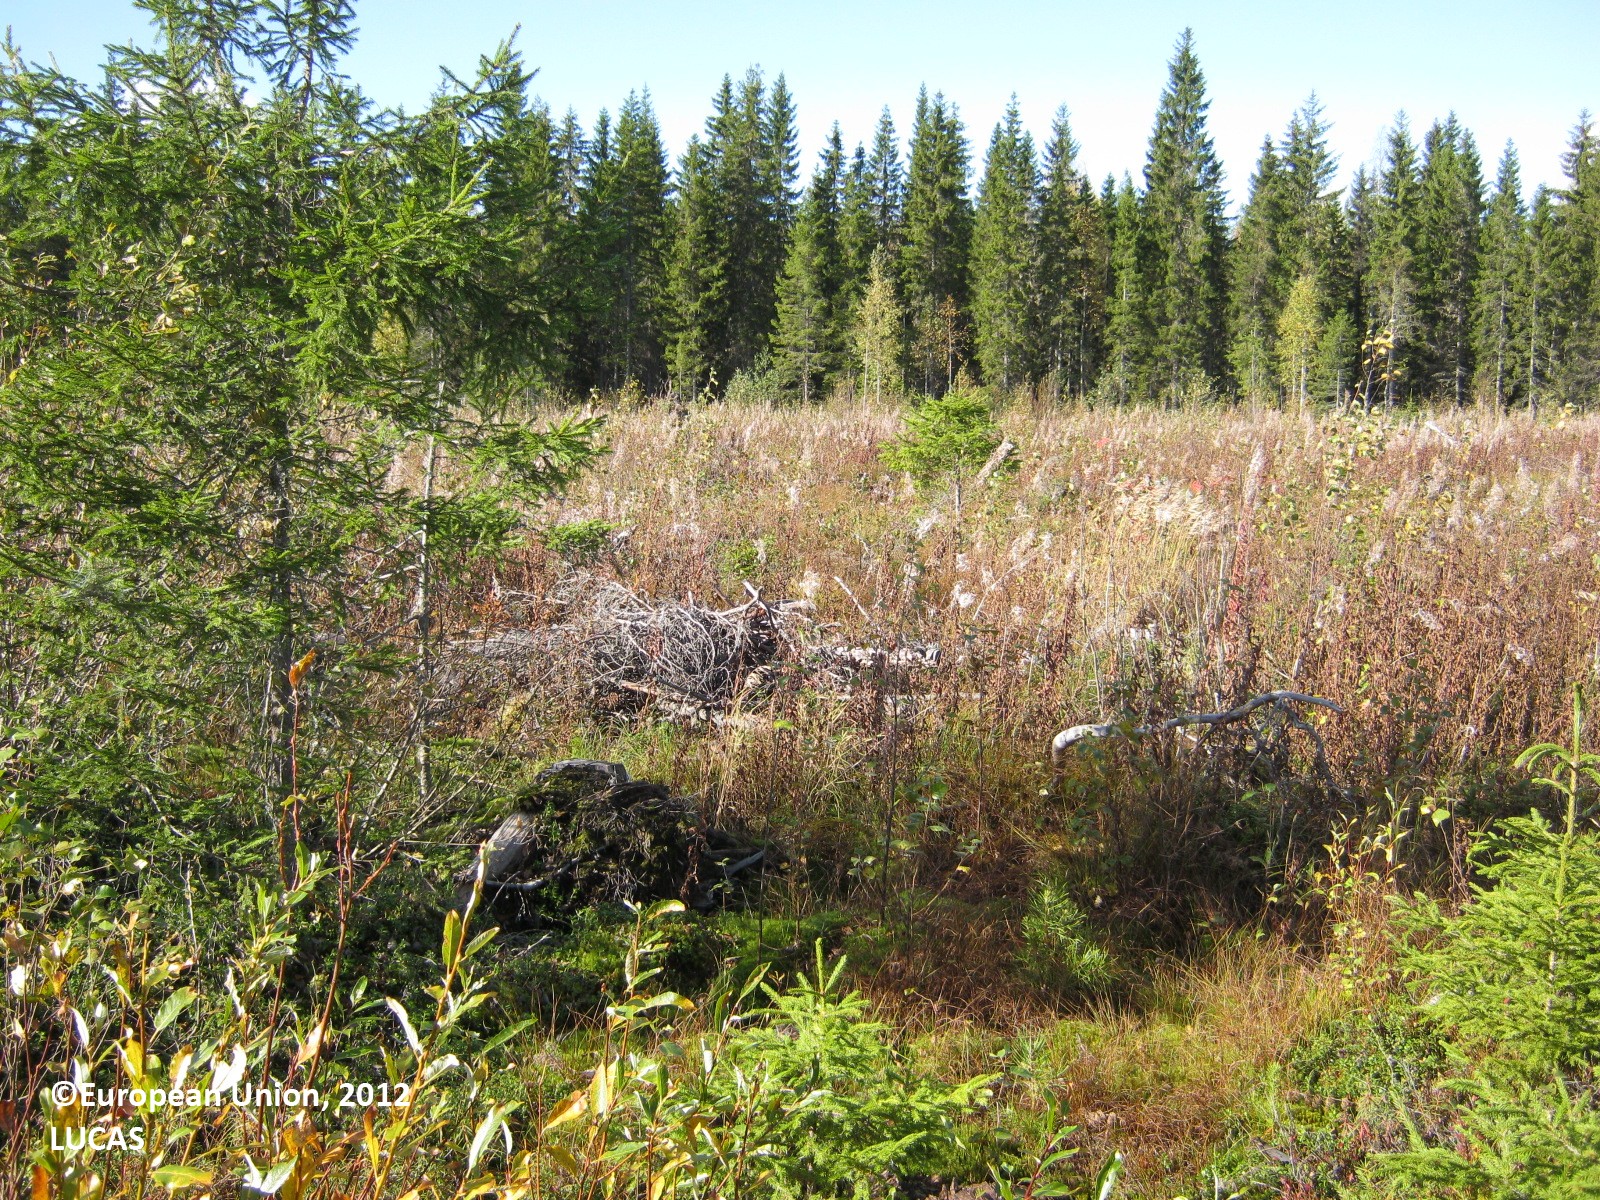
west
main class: Woodland
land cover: Broadleaved woodland
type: boreal forest
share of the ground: > 75 %
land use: Forestry
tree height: < 5 m
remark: Clear cut
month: September
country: FI
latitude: 63.4285
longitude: 25.8400
